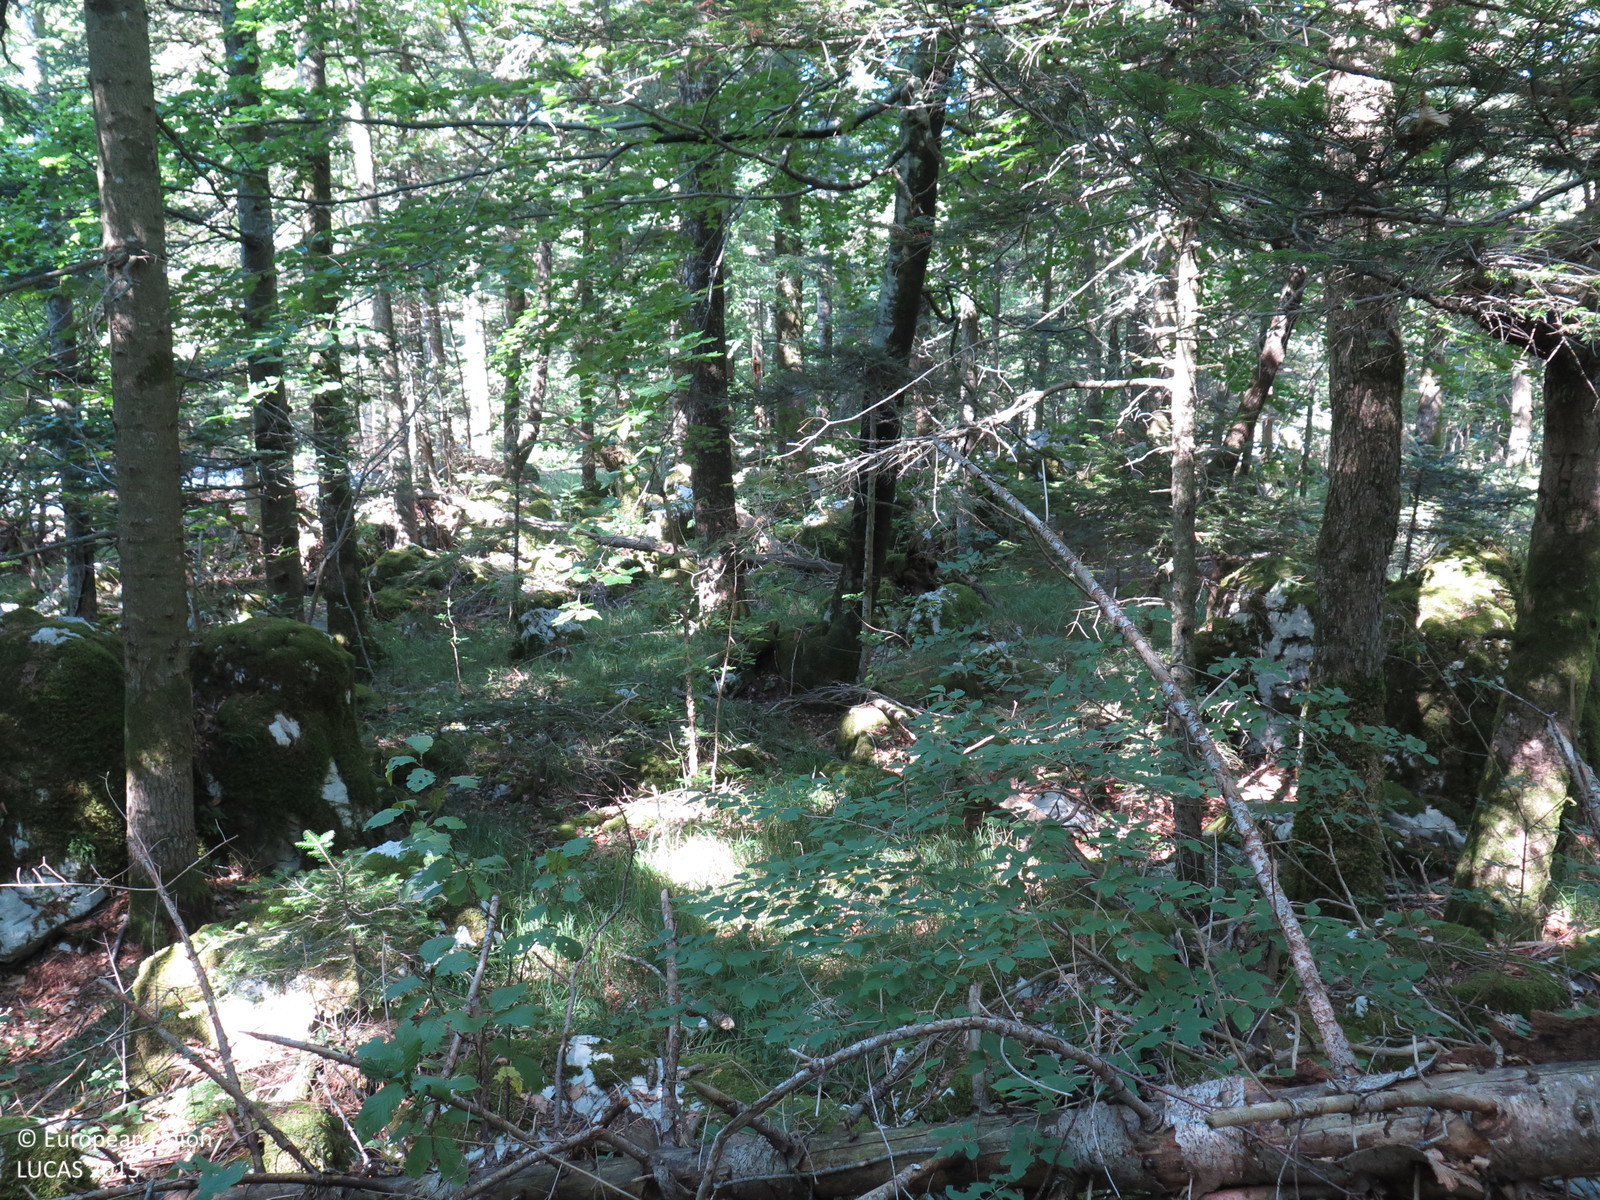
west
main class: Woodland
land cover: Other mixed woodland
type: mountainous beech forest
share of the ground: > 75 %
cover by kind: coniferous forest trees 75 %, broadleaved forest trees 25 %
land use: Forestry
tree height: > 5 m
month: August
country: HR
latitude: 45.1981
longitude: 14.7684
